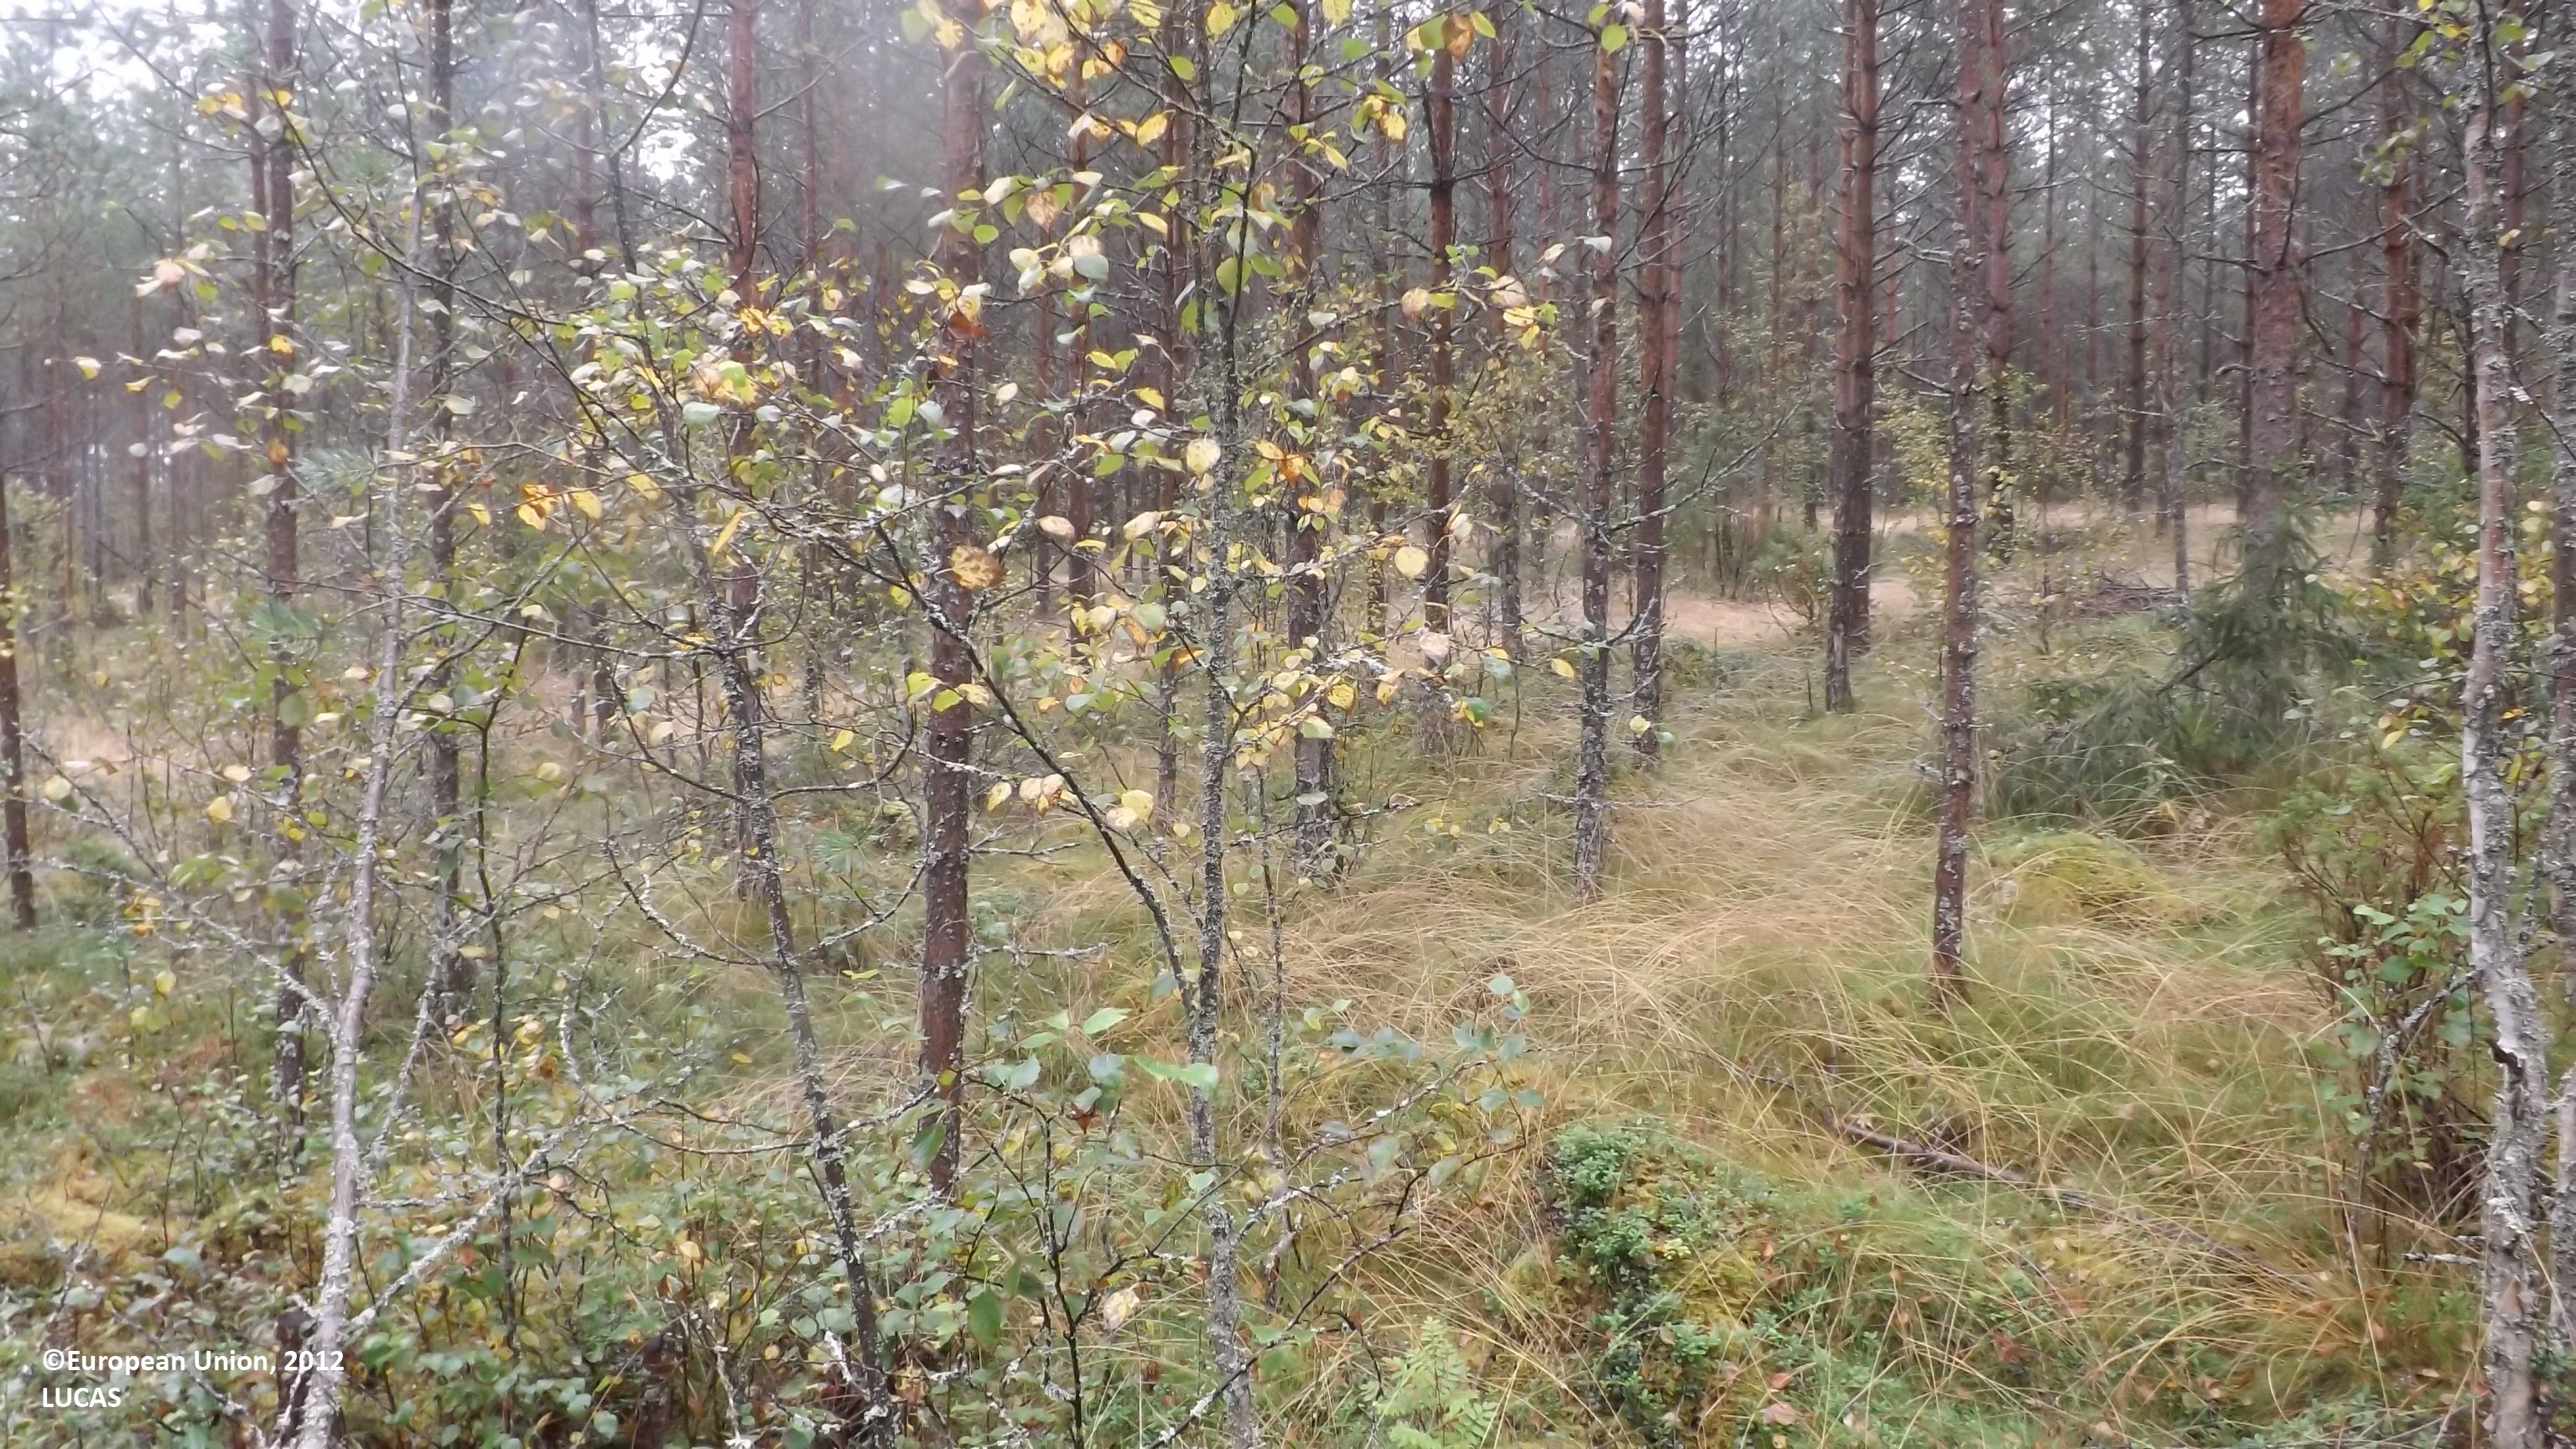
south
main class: Woodland
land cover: Pine dominated mixed woodland
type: boreal forest
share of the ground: 25 - 50 %
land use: Forestry
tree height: > 5 m
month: August
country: FI
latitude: 63.7912
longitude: 23.5971
